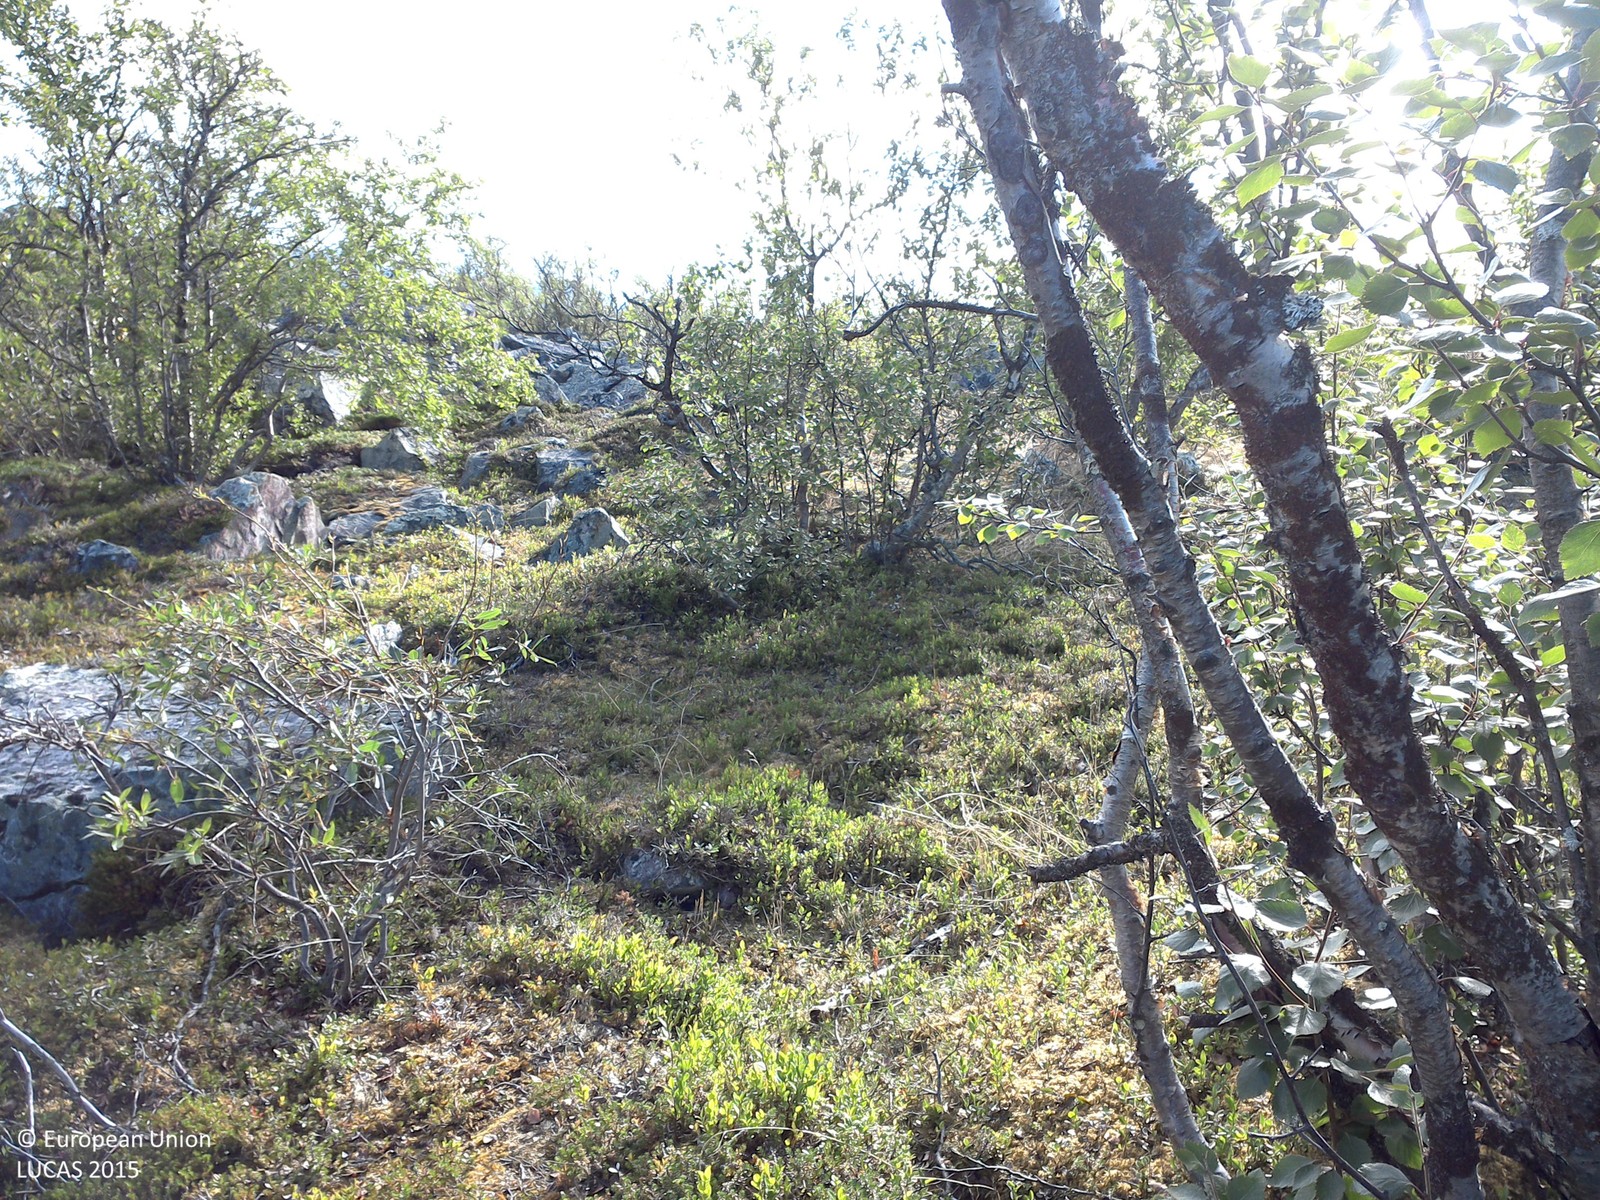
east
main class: Woodland
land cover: Broadleaved woodland
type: boreal forest
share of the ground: 10 - 25 %
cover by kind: shrubs 55 %, broadleaved forest trees 20 %, lichens and mosses 20 %, unconsolidated bare surface 5 %
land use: Amenities, museums, leisure
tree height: < 5 m
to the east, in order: Broadleaved woodland; Rocks and stones; Broadleaved woodland
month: August
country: SE
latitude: 68.3500
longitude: 19.0885
